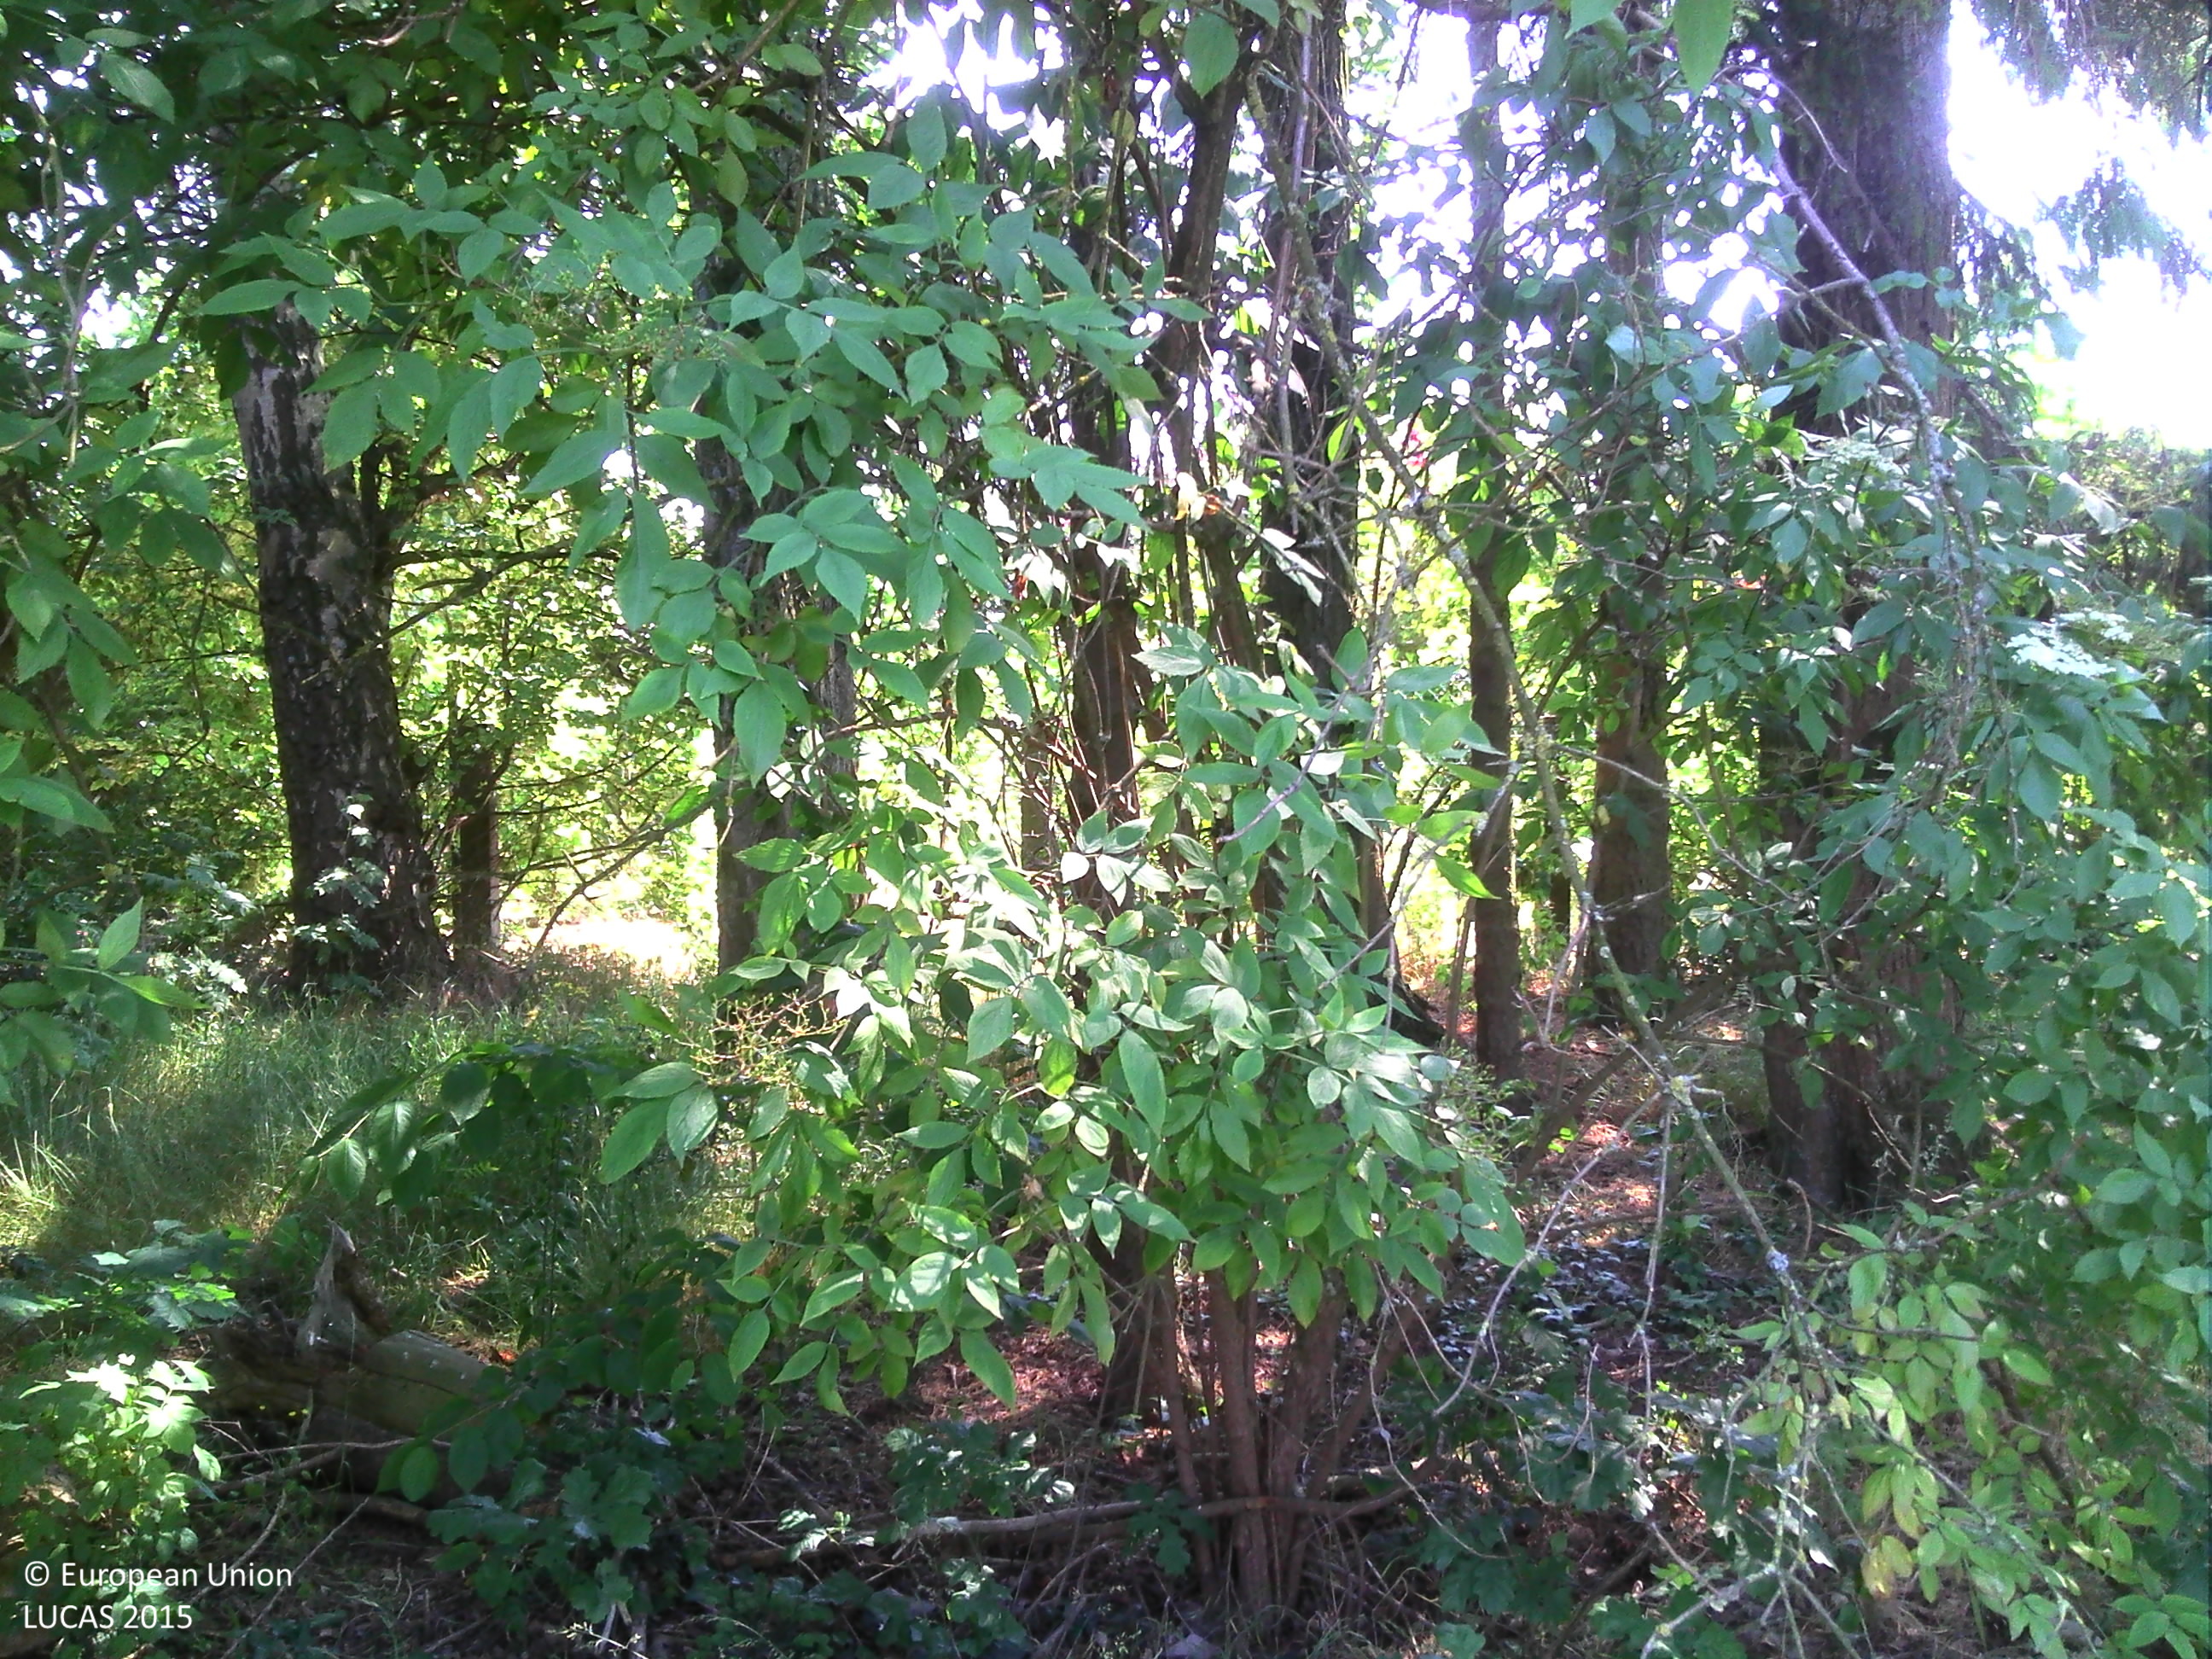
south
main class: Woodland
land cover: Other mixed woodland
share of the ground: > 75 %
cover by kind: broadleaved forest trees 70 %, coniferous forest trees 25 %, herbaceous plants 5 %
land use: Residential
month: June
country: BE
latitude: 50.9478
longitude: 5.2008
